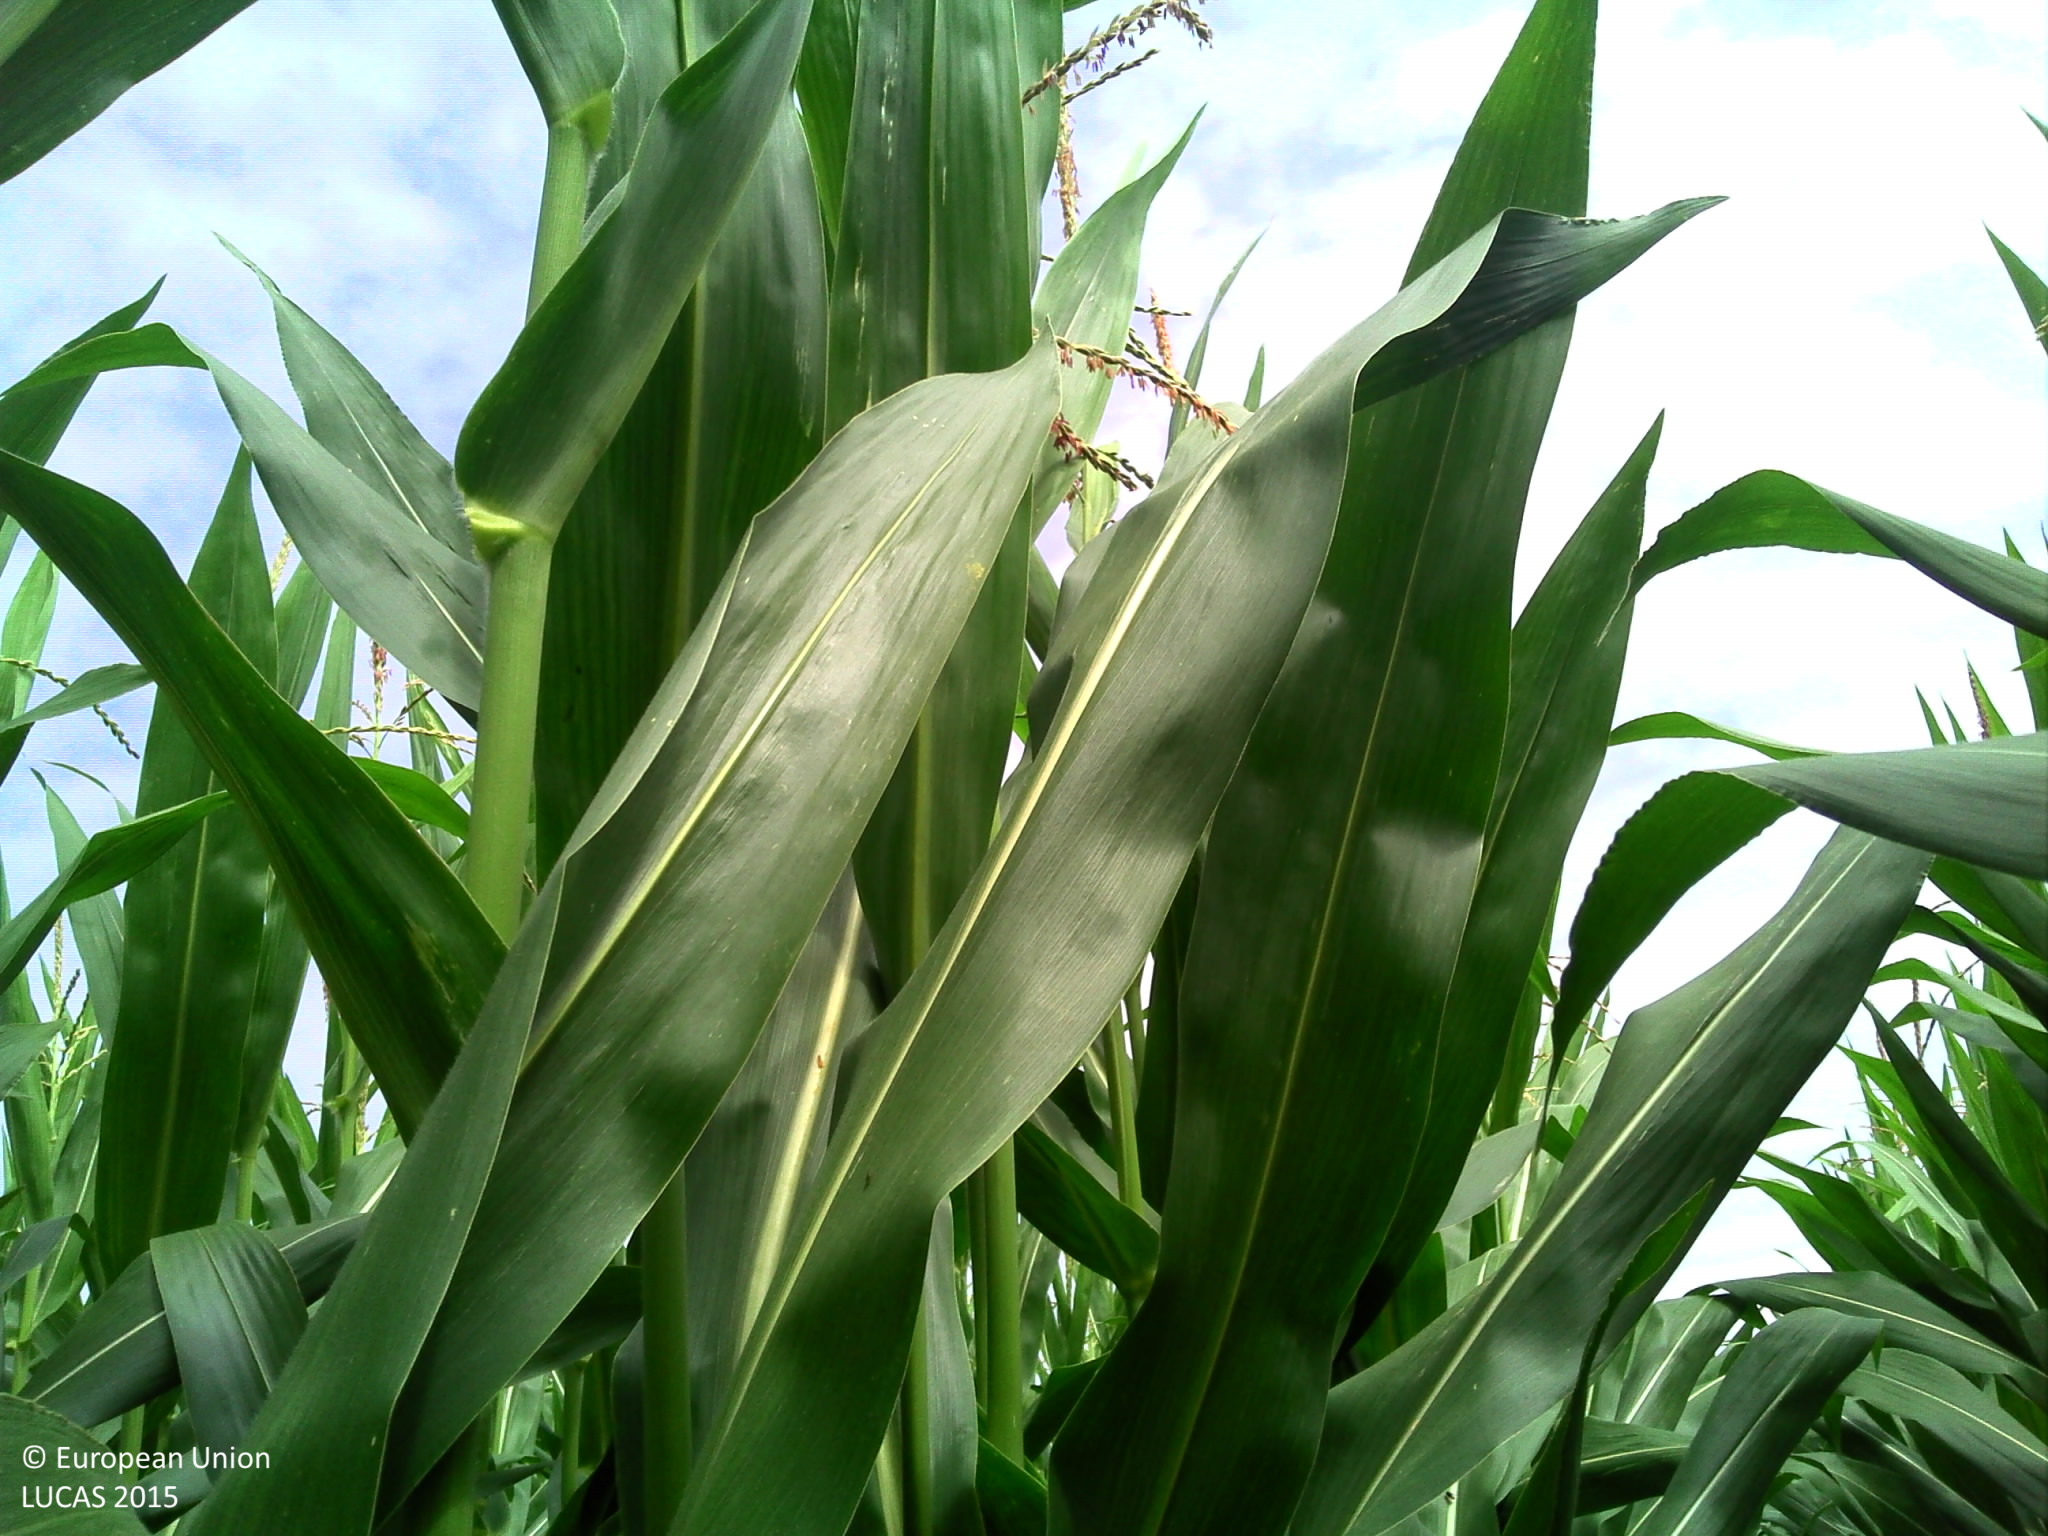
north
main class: Cropland
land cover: Maize
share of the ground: 50 - 75 %
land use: Agriculture (excluding fallow land and kitchen gardens)
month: August
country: FR
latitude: 48.4734
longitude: -3.4283
